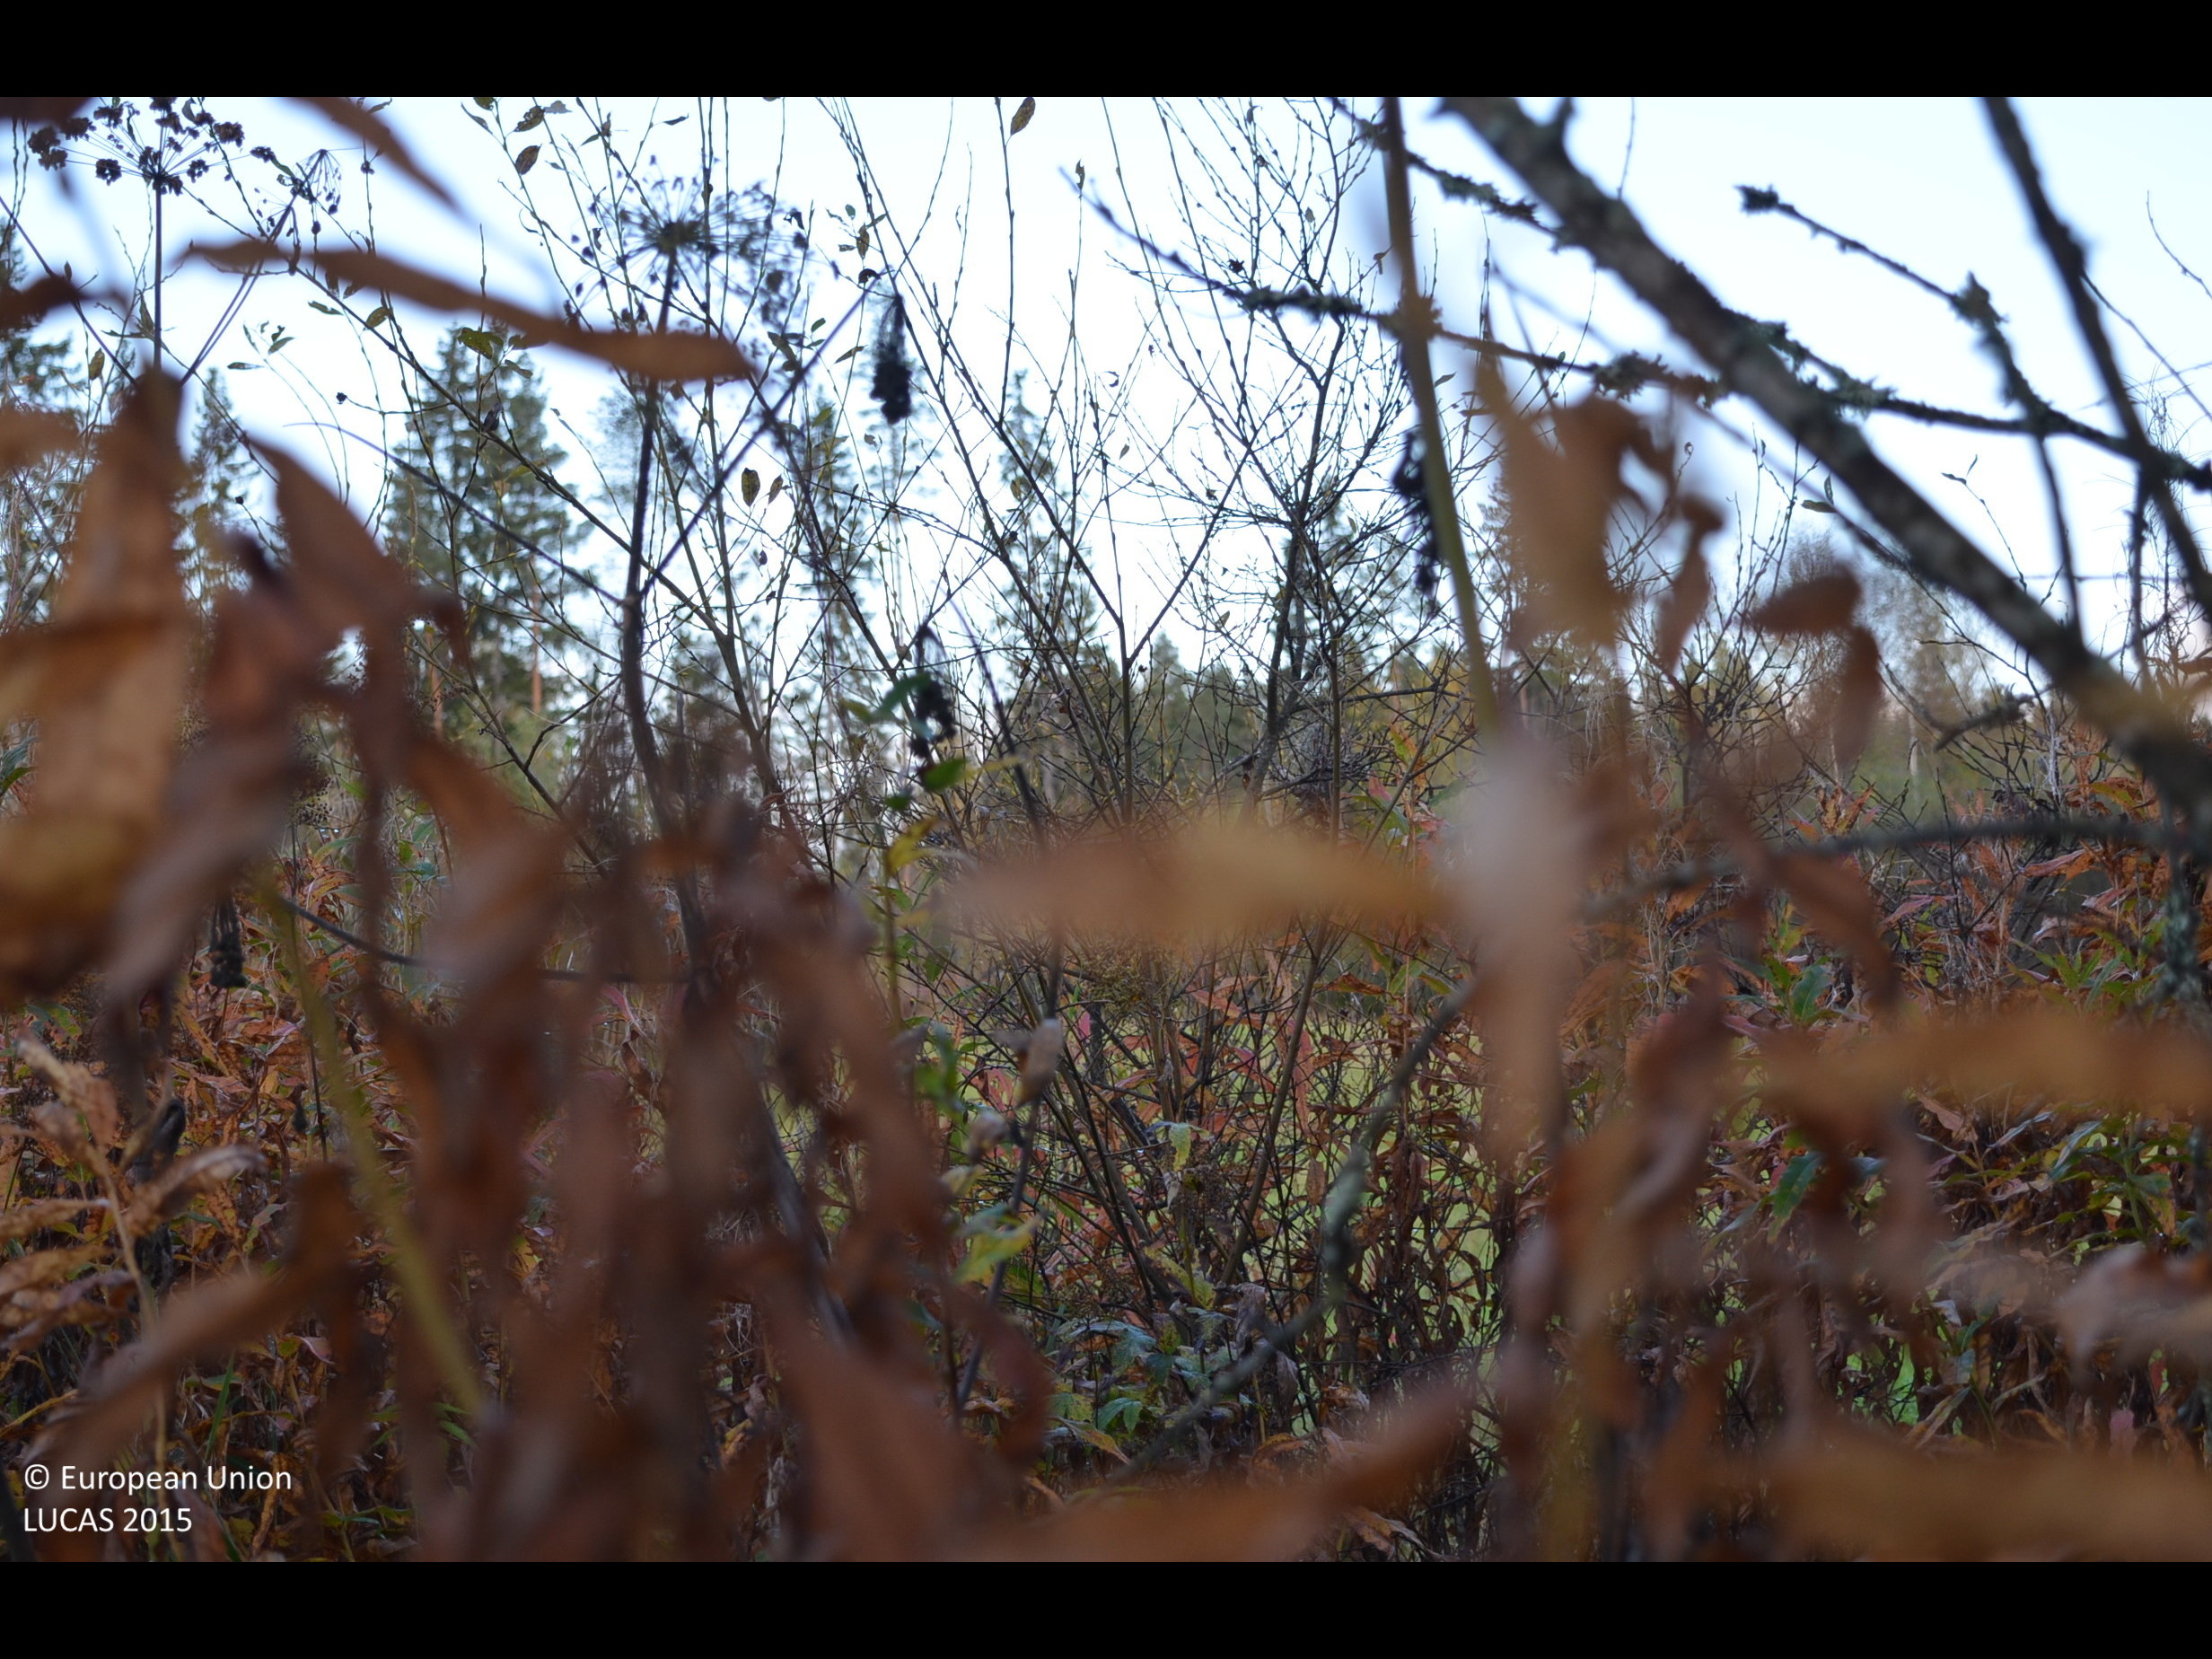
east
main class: Woodland
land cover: Broadleaved woodland
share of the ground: 50 - 75 %
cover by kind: broadleaved forest trees 60 %, herbaceous plants 40 %
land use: Semi-natural and natural areas not in use
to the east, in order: Broadleaved woodland; Electric lines; Grassland without tree/shrub cover; Temporary grasslands; Abandoned hedges; Ditches and canals; Shrubland without tree cover; Spruce dominated mixed woodland; Inland fresh running water; Grassland without tree/shrub cover; Spruce dominated mixed woodland; Grassland without tree/shrub cover; Oats; Ditches and canals; Tracks
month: September
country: FI
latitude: 62.4166
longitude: 23.5659
